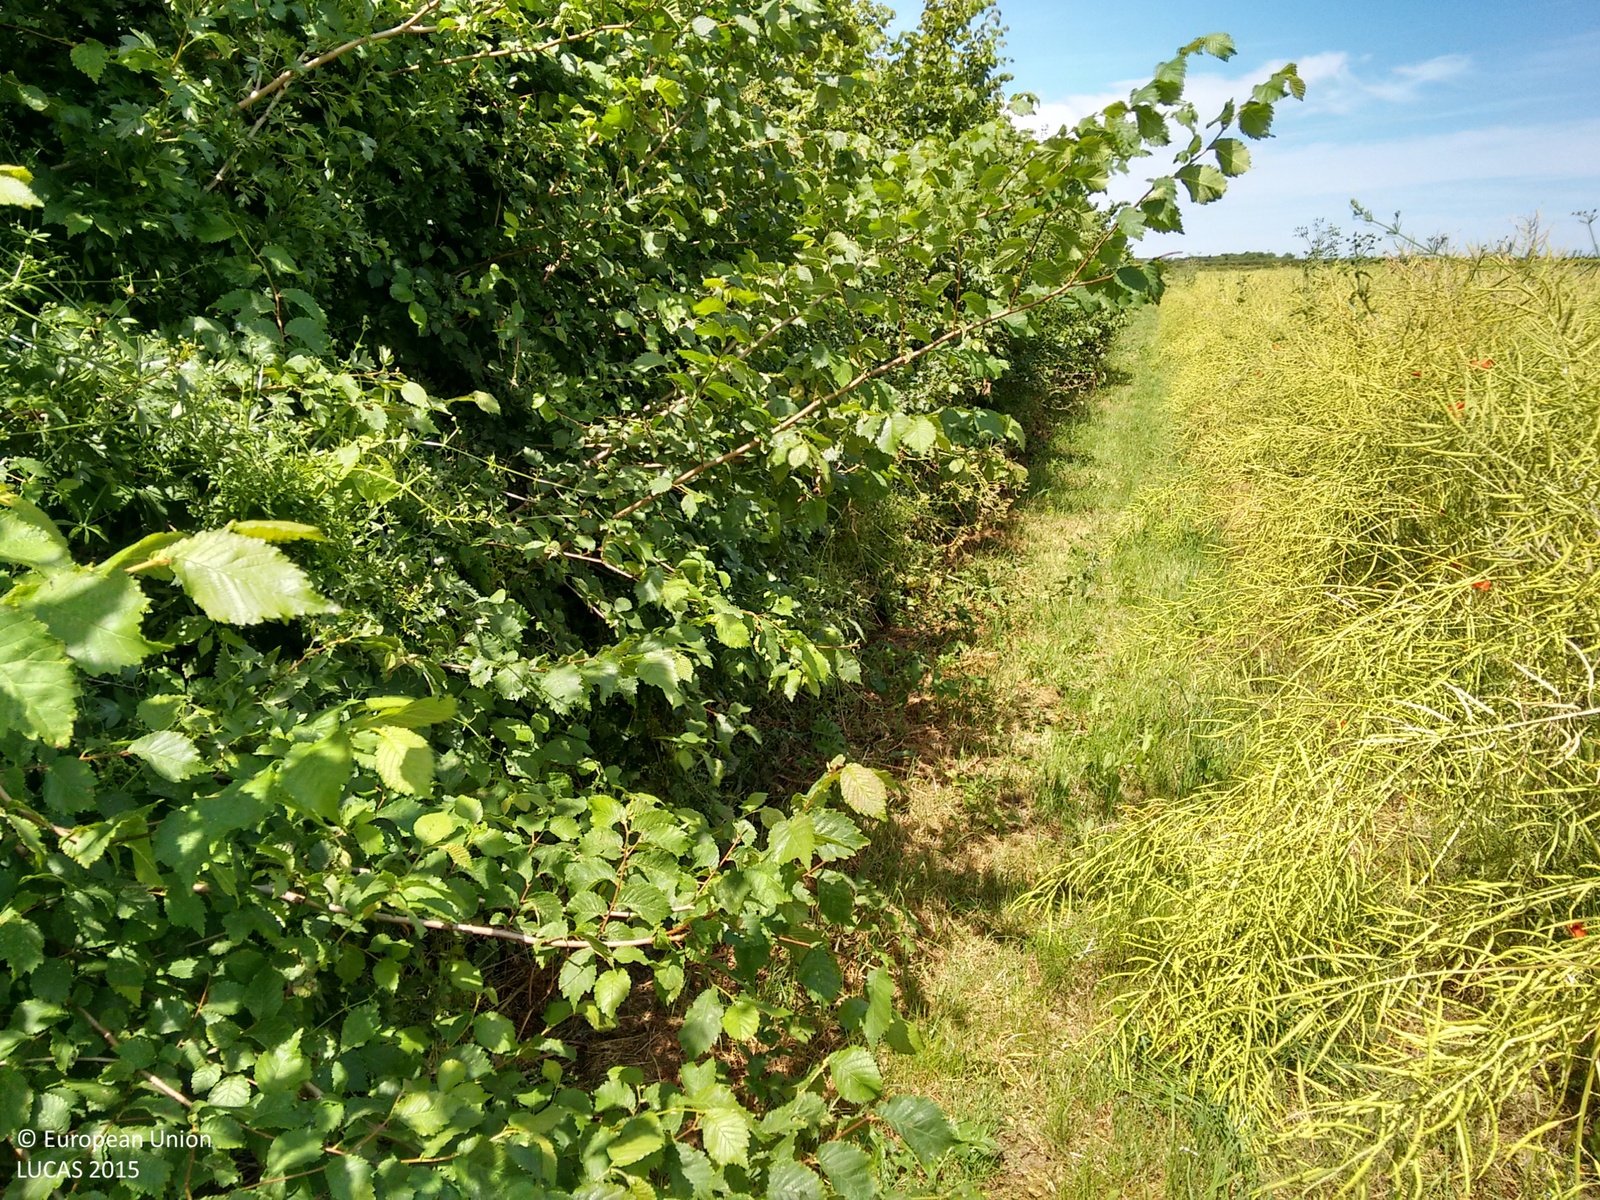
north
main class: Cropland
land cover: Rape and turnip rape
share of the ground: > 75 %
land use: Agriculture (excluding fallow land and kitchen gardens)
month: July
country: GB
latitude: 52.8991
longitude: -1.0001
